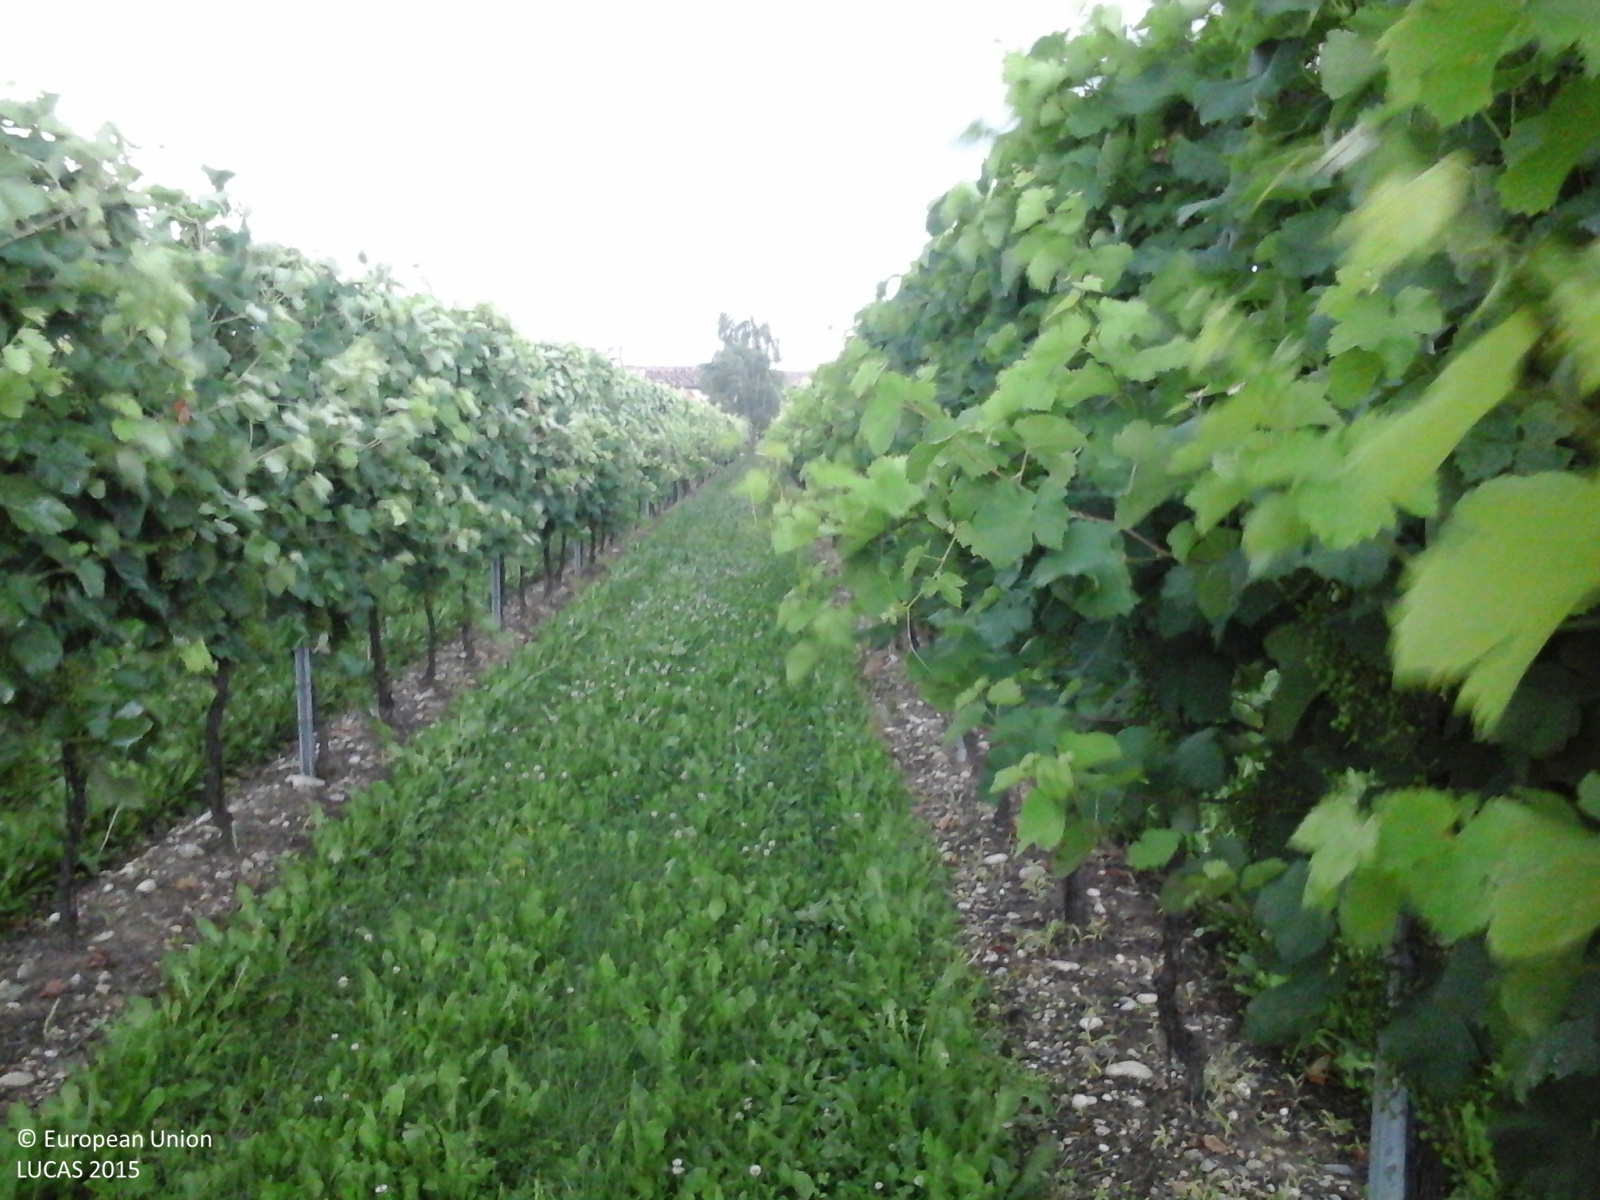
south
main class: Cropland
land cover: Vineyards
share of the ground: < 10 %
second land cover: Grassland without tree/shrub cover
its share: > 75 %
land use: Agriculture (excluding fallow land and kitchen gardens)
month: June
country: IT
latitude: 45.8393
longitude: 12.3272
